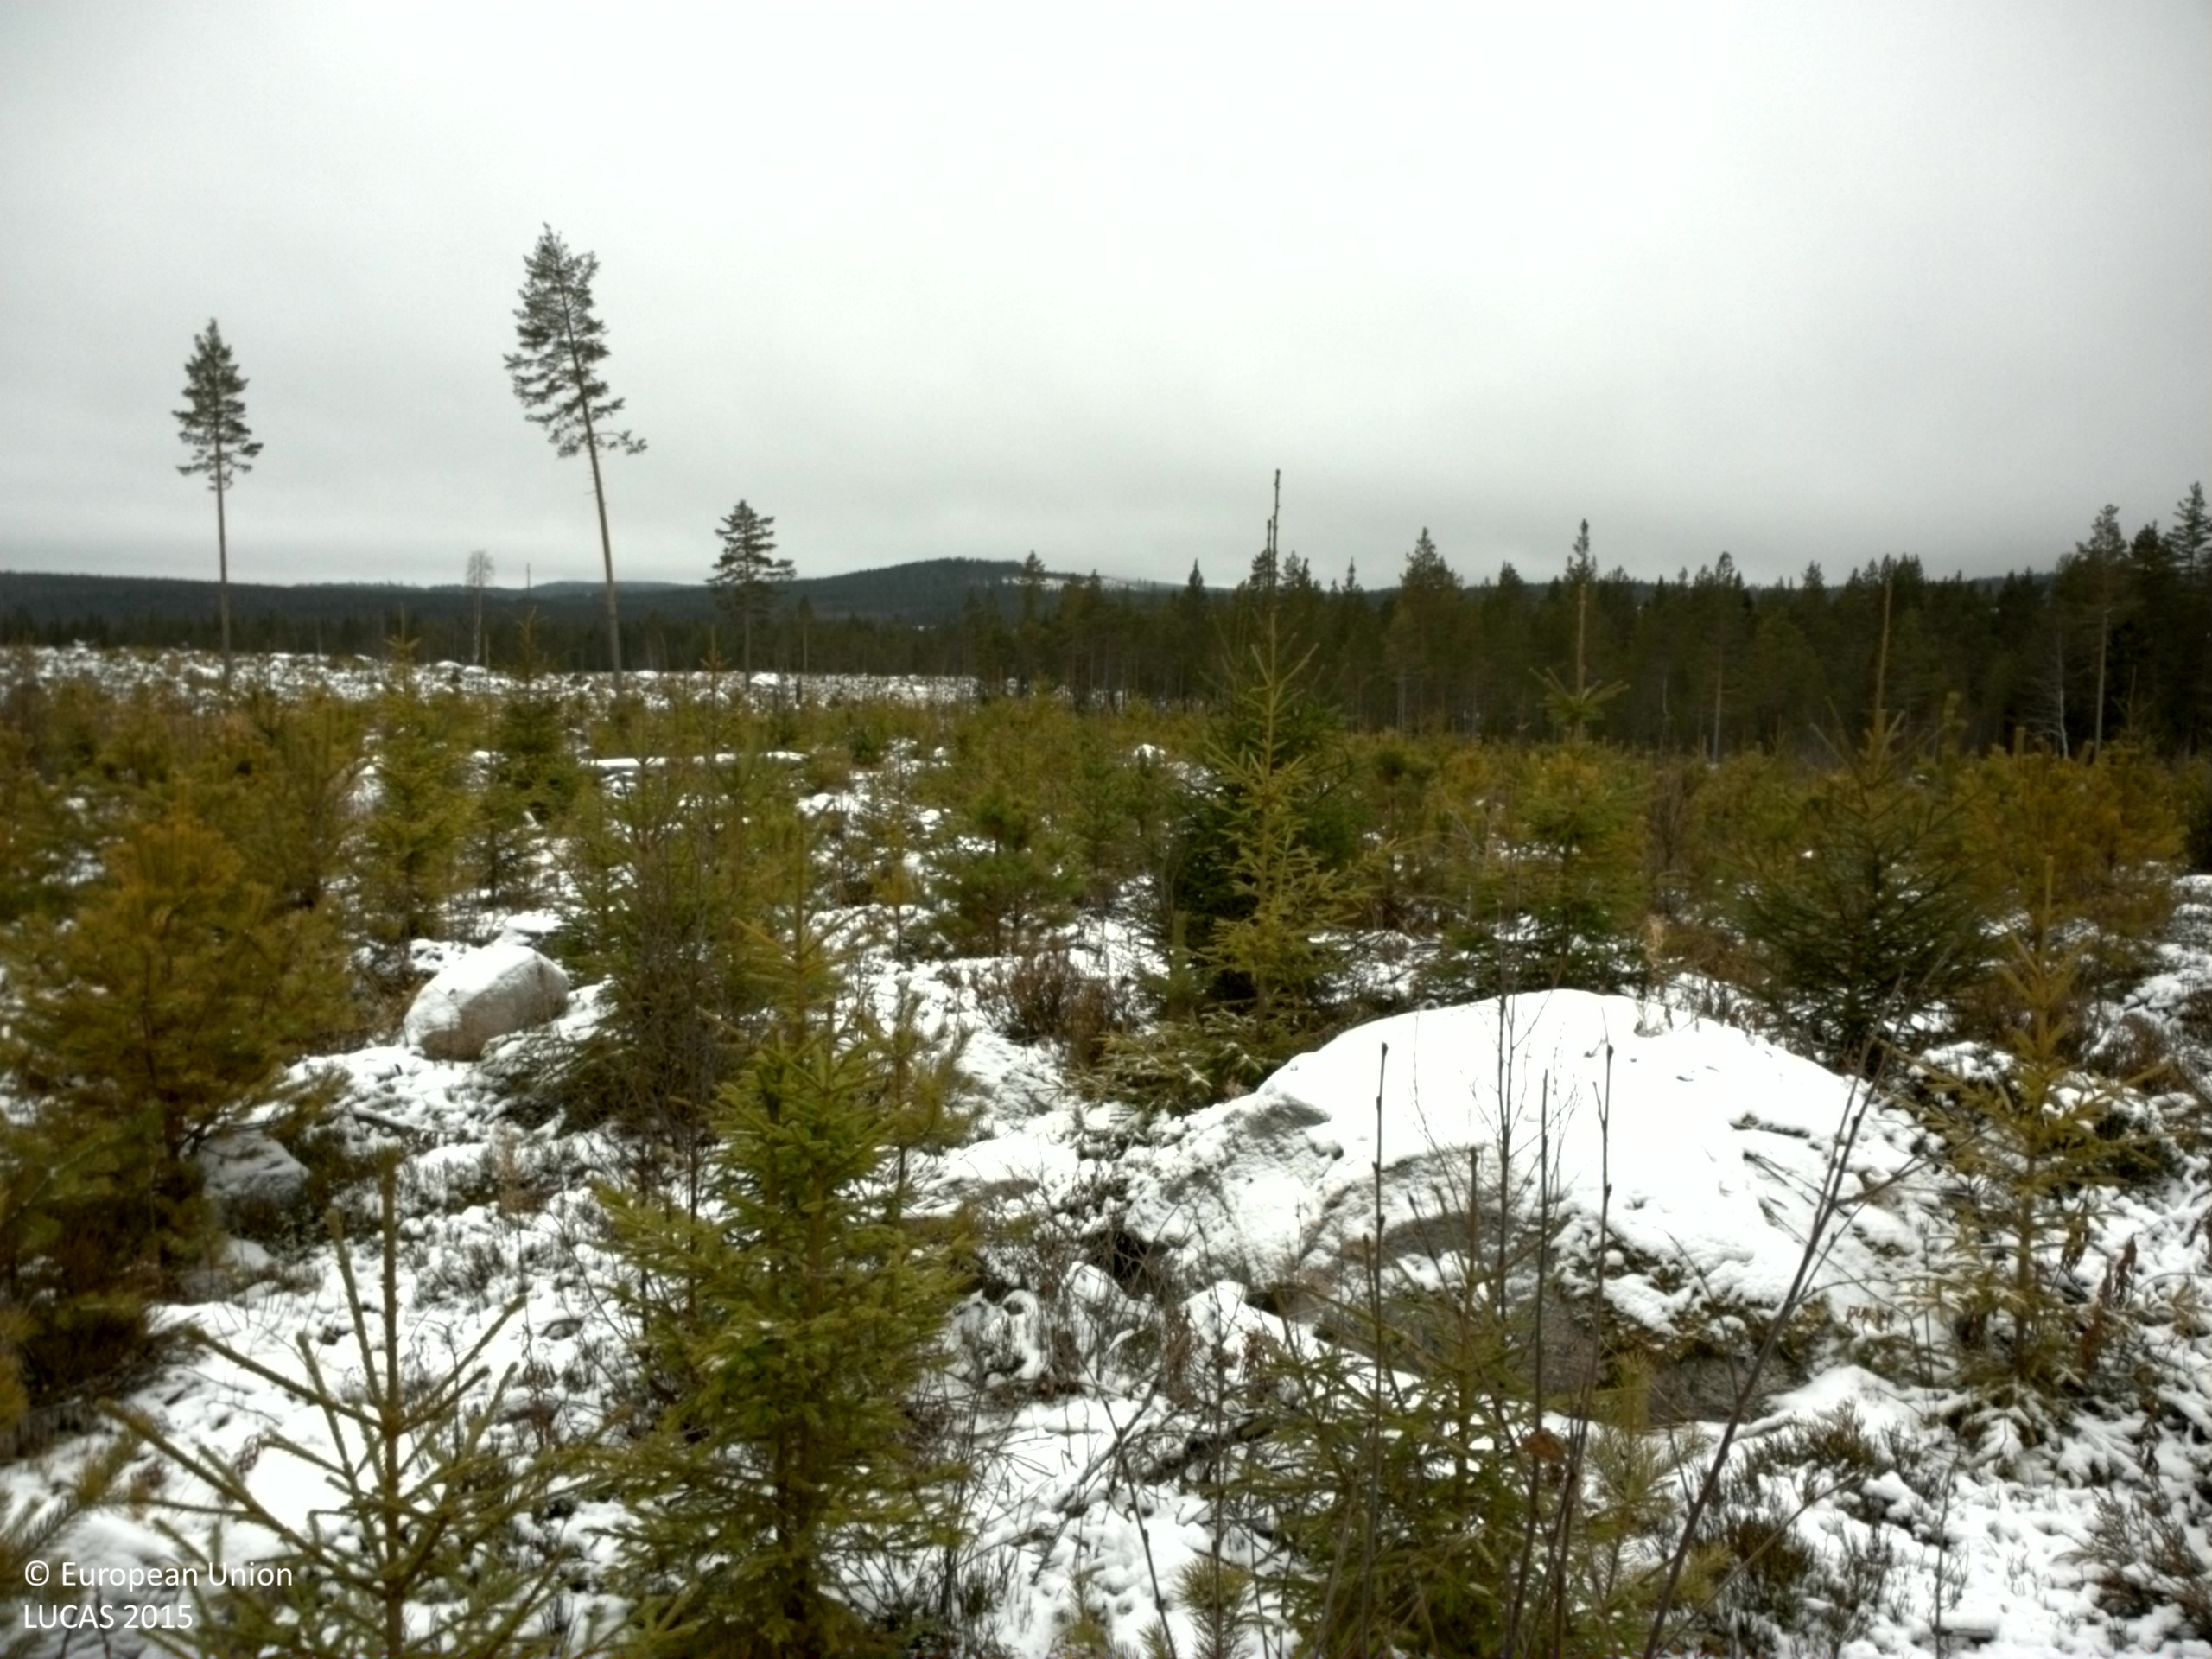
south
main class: Woodland
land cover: Other coniferous woodland
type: boreal forest
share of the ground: 25 - 50 %
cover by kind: shrubs 45 %, coniferous forest trees 25 %, lichens and mosses 20 %, broadleaved forest trees 5 %, consolidated bare surface 5 %
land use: Forestry
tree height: < 5 m
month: November
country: SE
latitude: 61.7668
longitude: 15.6107
